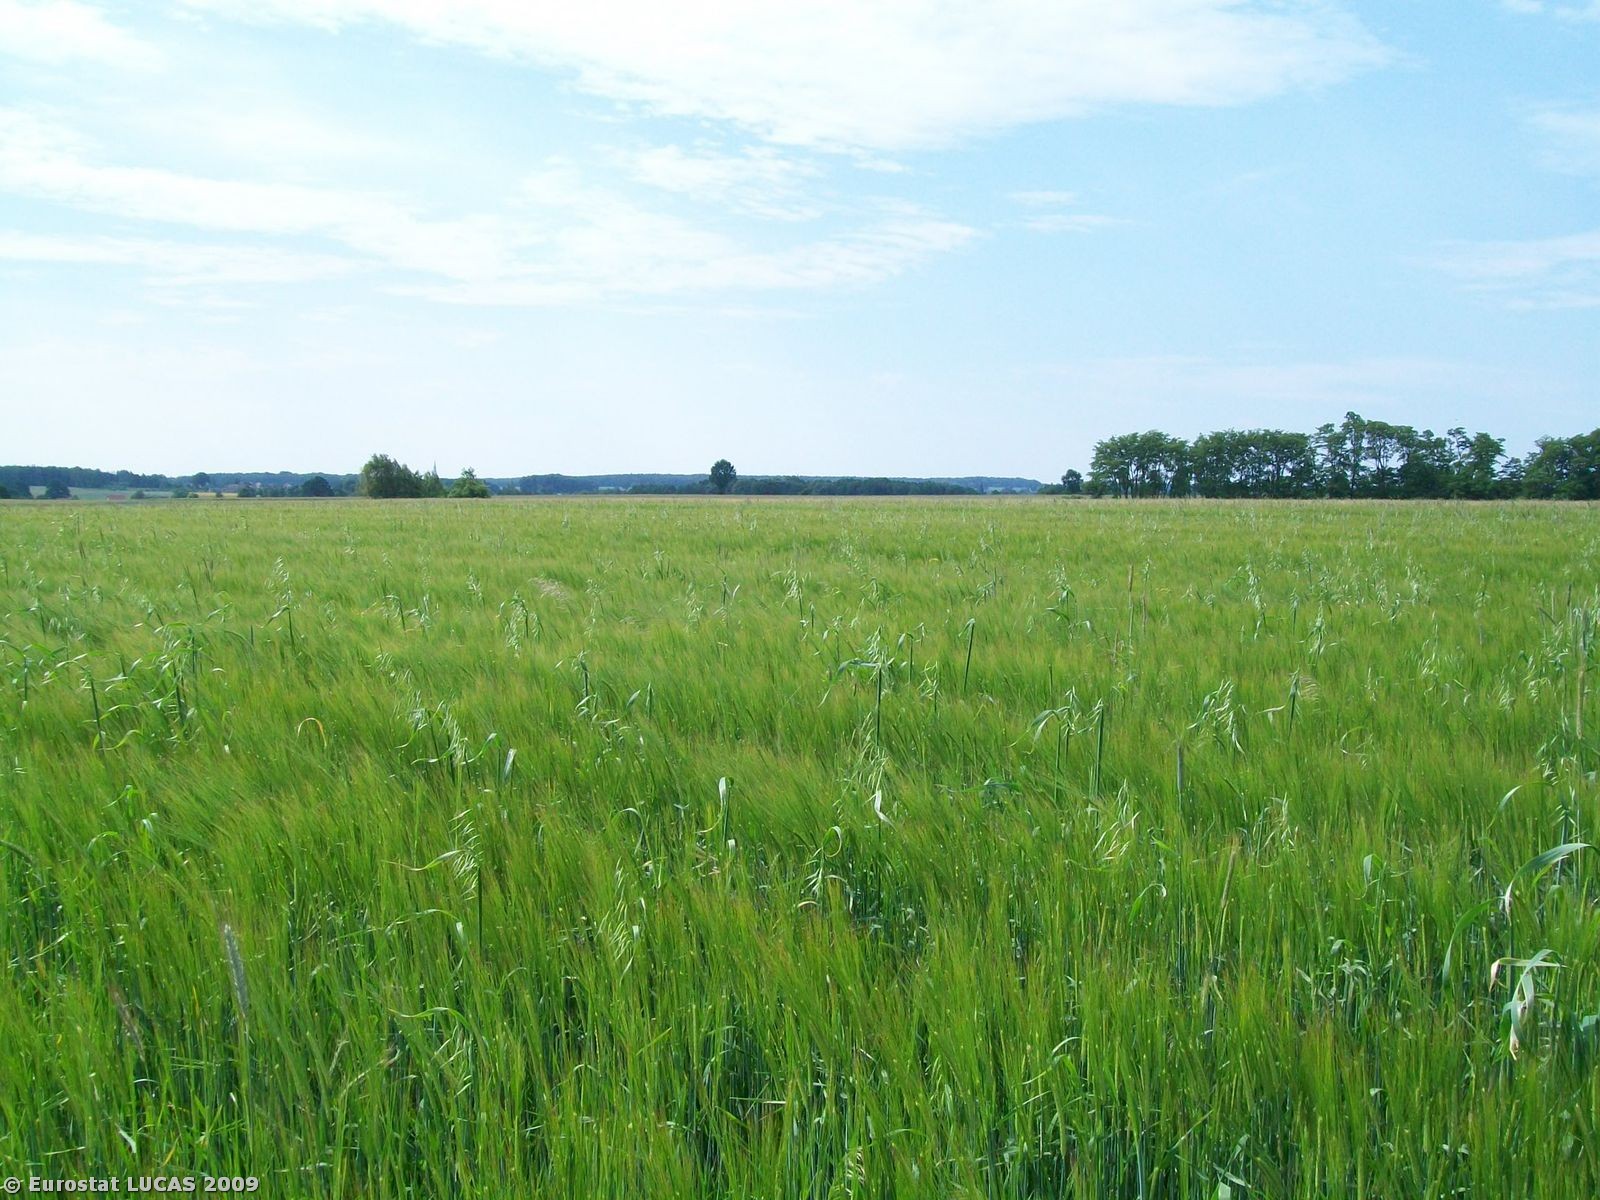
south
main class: Cropland
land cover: Barley
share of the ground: > 75 %
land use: Agriculture (excluding fallow land and kitchen gardens)
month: June
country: PL
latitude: 51.7052
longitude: 15.1983
